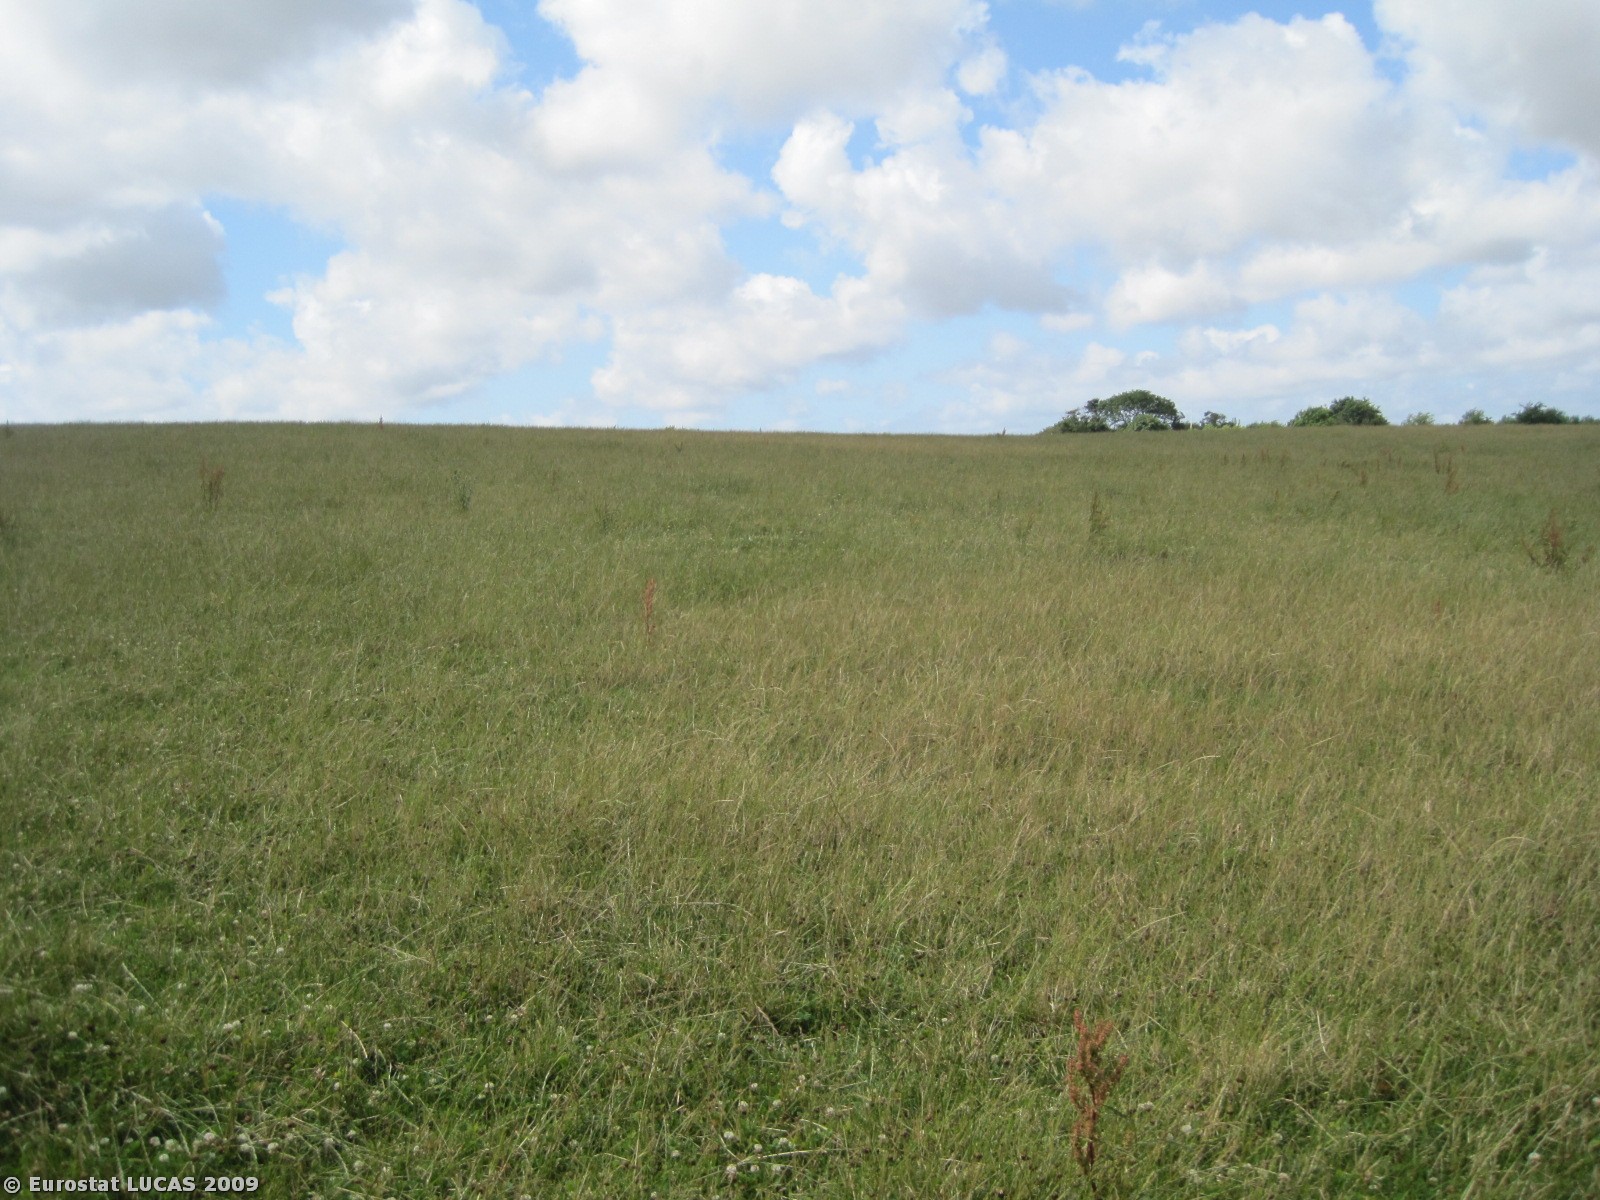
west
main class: Grassland
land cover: Grassland with sparse tree/shrub cover
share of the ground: > 75 %
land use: Unused
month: July
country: DK
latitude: 56.8620
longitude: 8.4767
